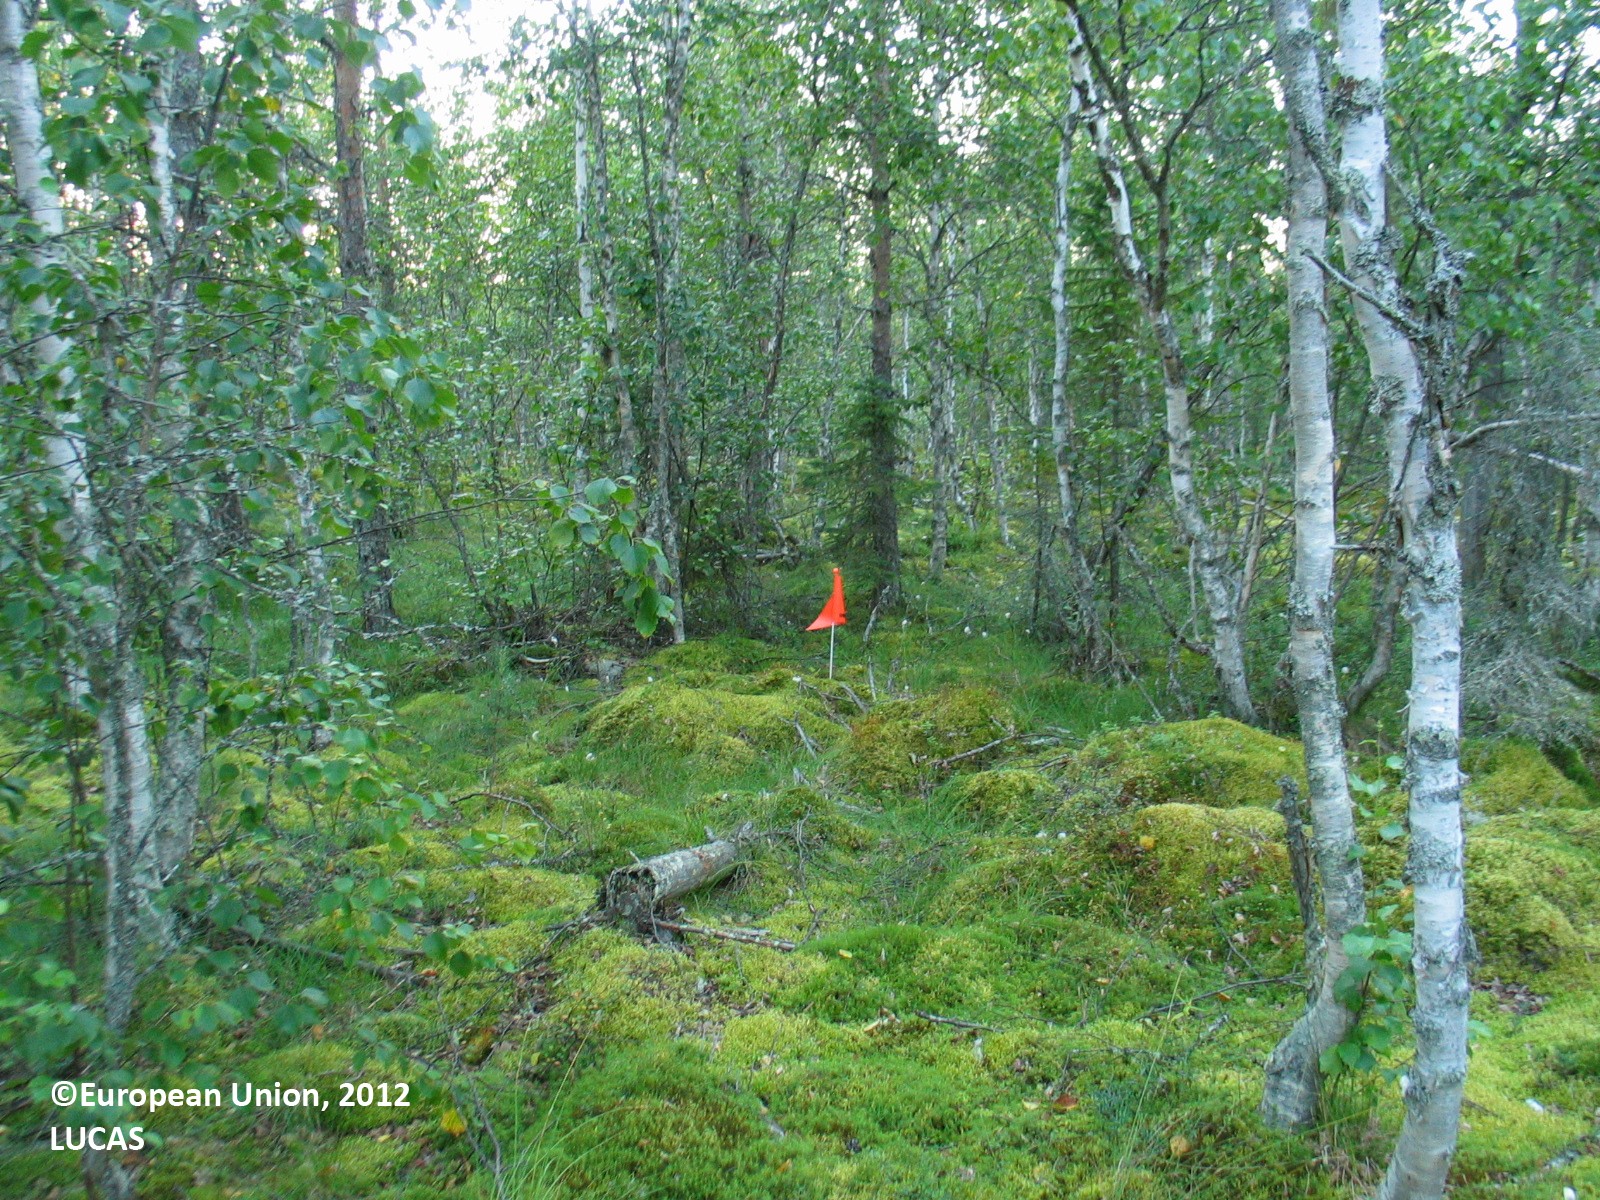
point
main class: Woodland
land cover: Other mixed woodland
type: mire and swamp forests
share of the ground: 50 - 75 %
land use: Semi-natural and natural areas not in use
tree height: > 5 m
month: July
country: FI
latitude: 64.6125
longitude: 26.5667
